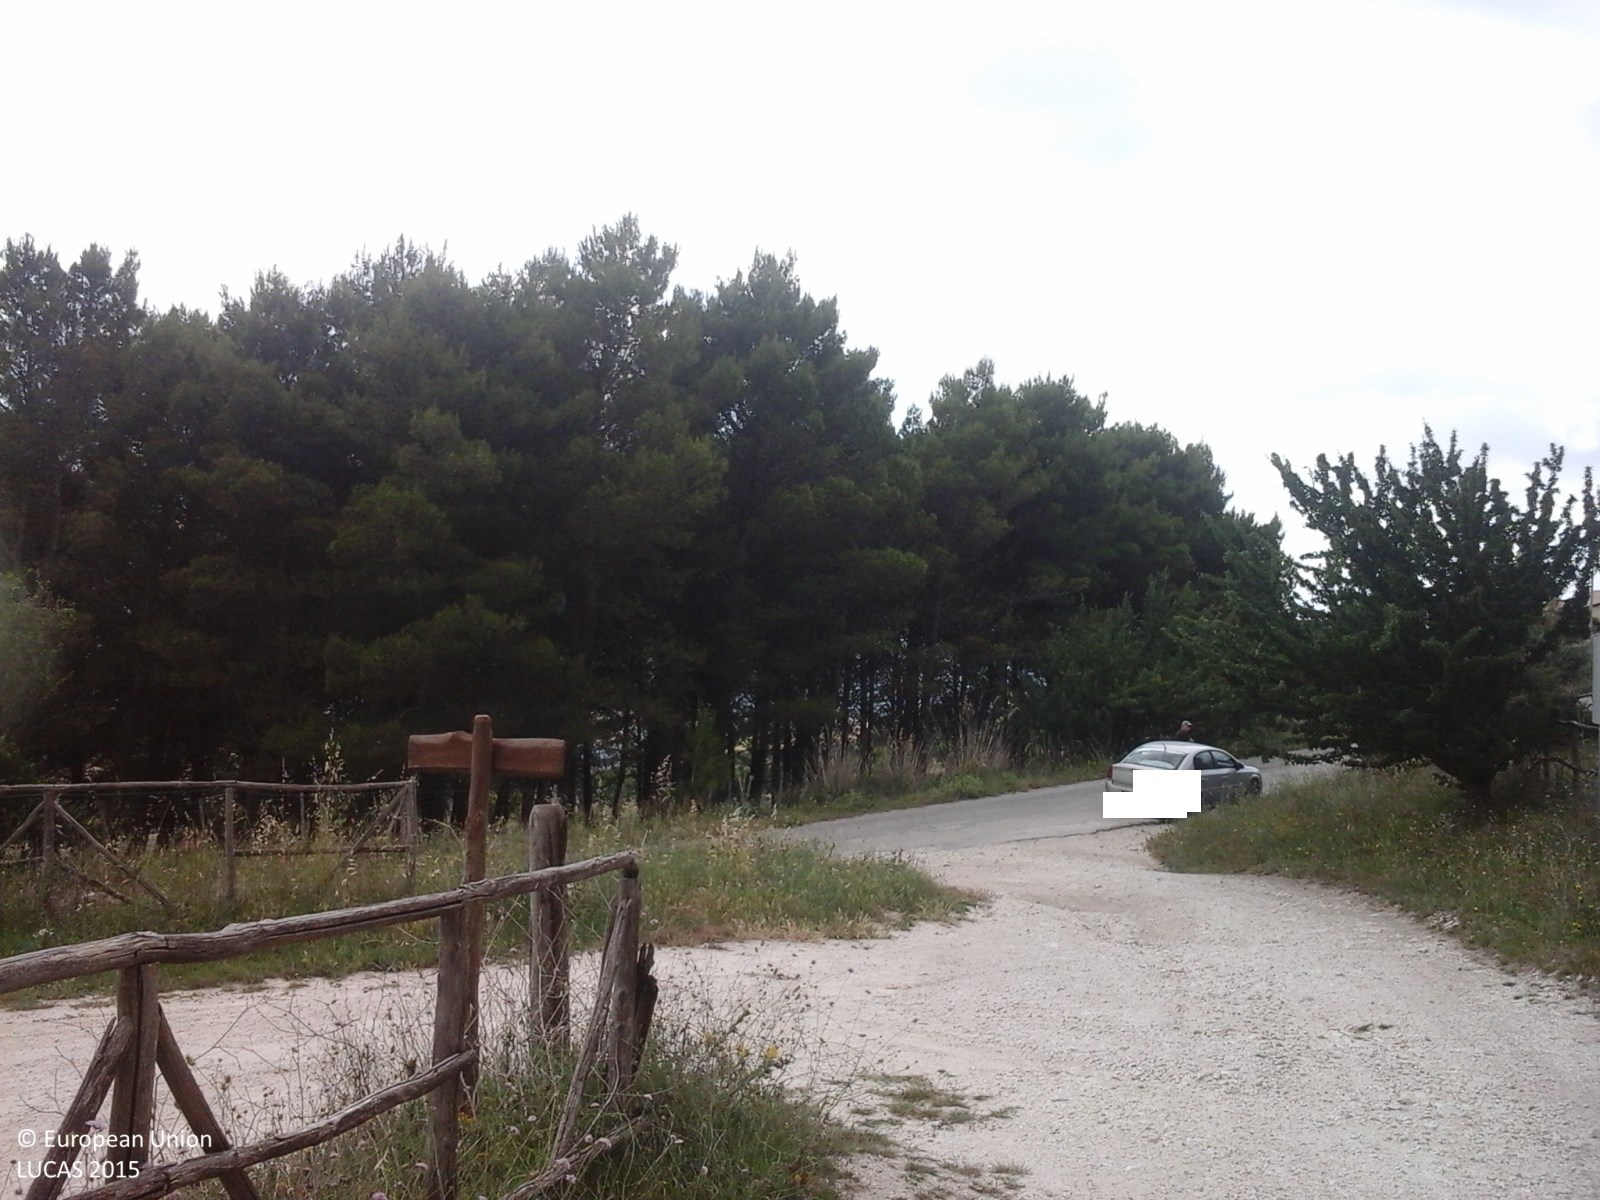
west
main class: Woodland
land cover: Pine dominated mixed woodland
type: coniferous forest of the mediterranean region
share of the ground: > 75 %
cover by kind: coniferous forest trees 75 %, broadleaved forest trees 25 %
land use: Forestry
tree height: > 5 m
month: June
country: IT
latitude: 37.6949
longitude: 13.1632
